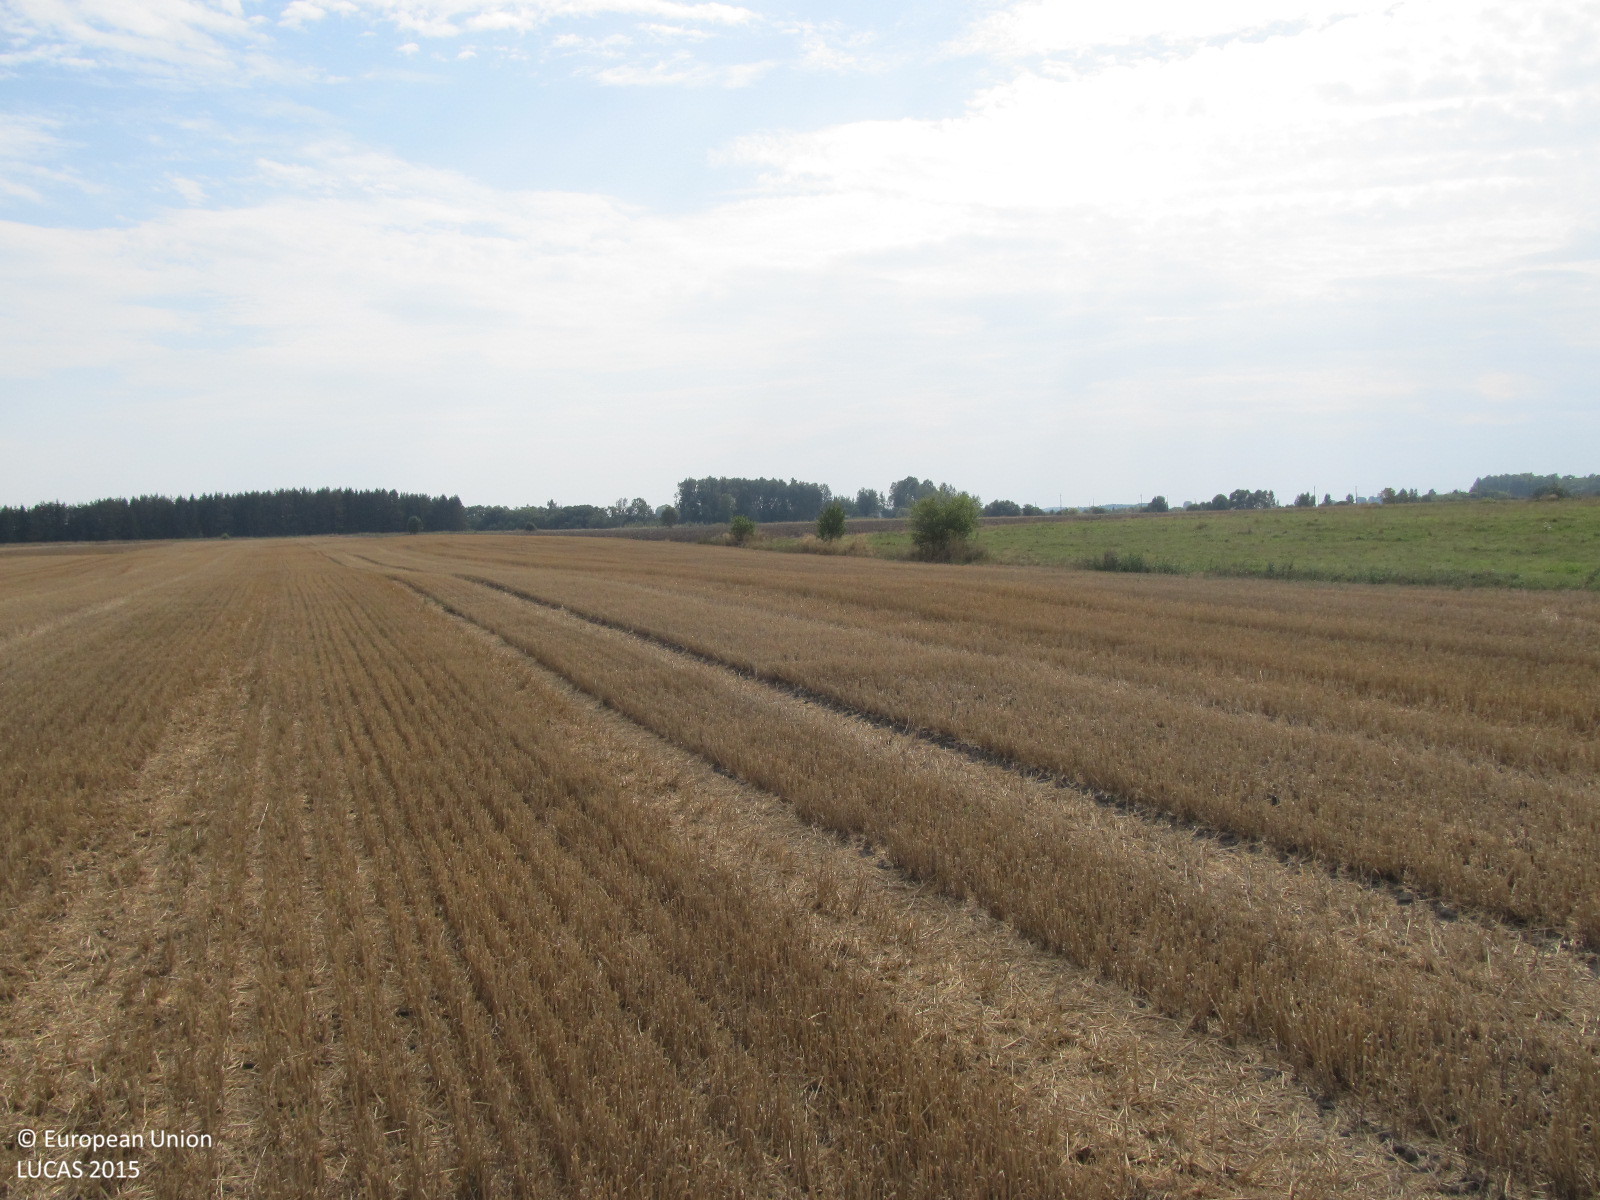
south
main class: Cropland
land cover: Barley
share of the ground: > 75 %
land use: Agriculture (excluding fallow land and kitchen gardens)
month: August
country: LT
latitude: 55.6627
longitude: 23.0575
